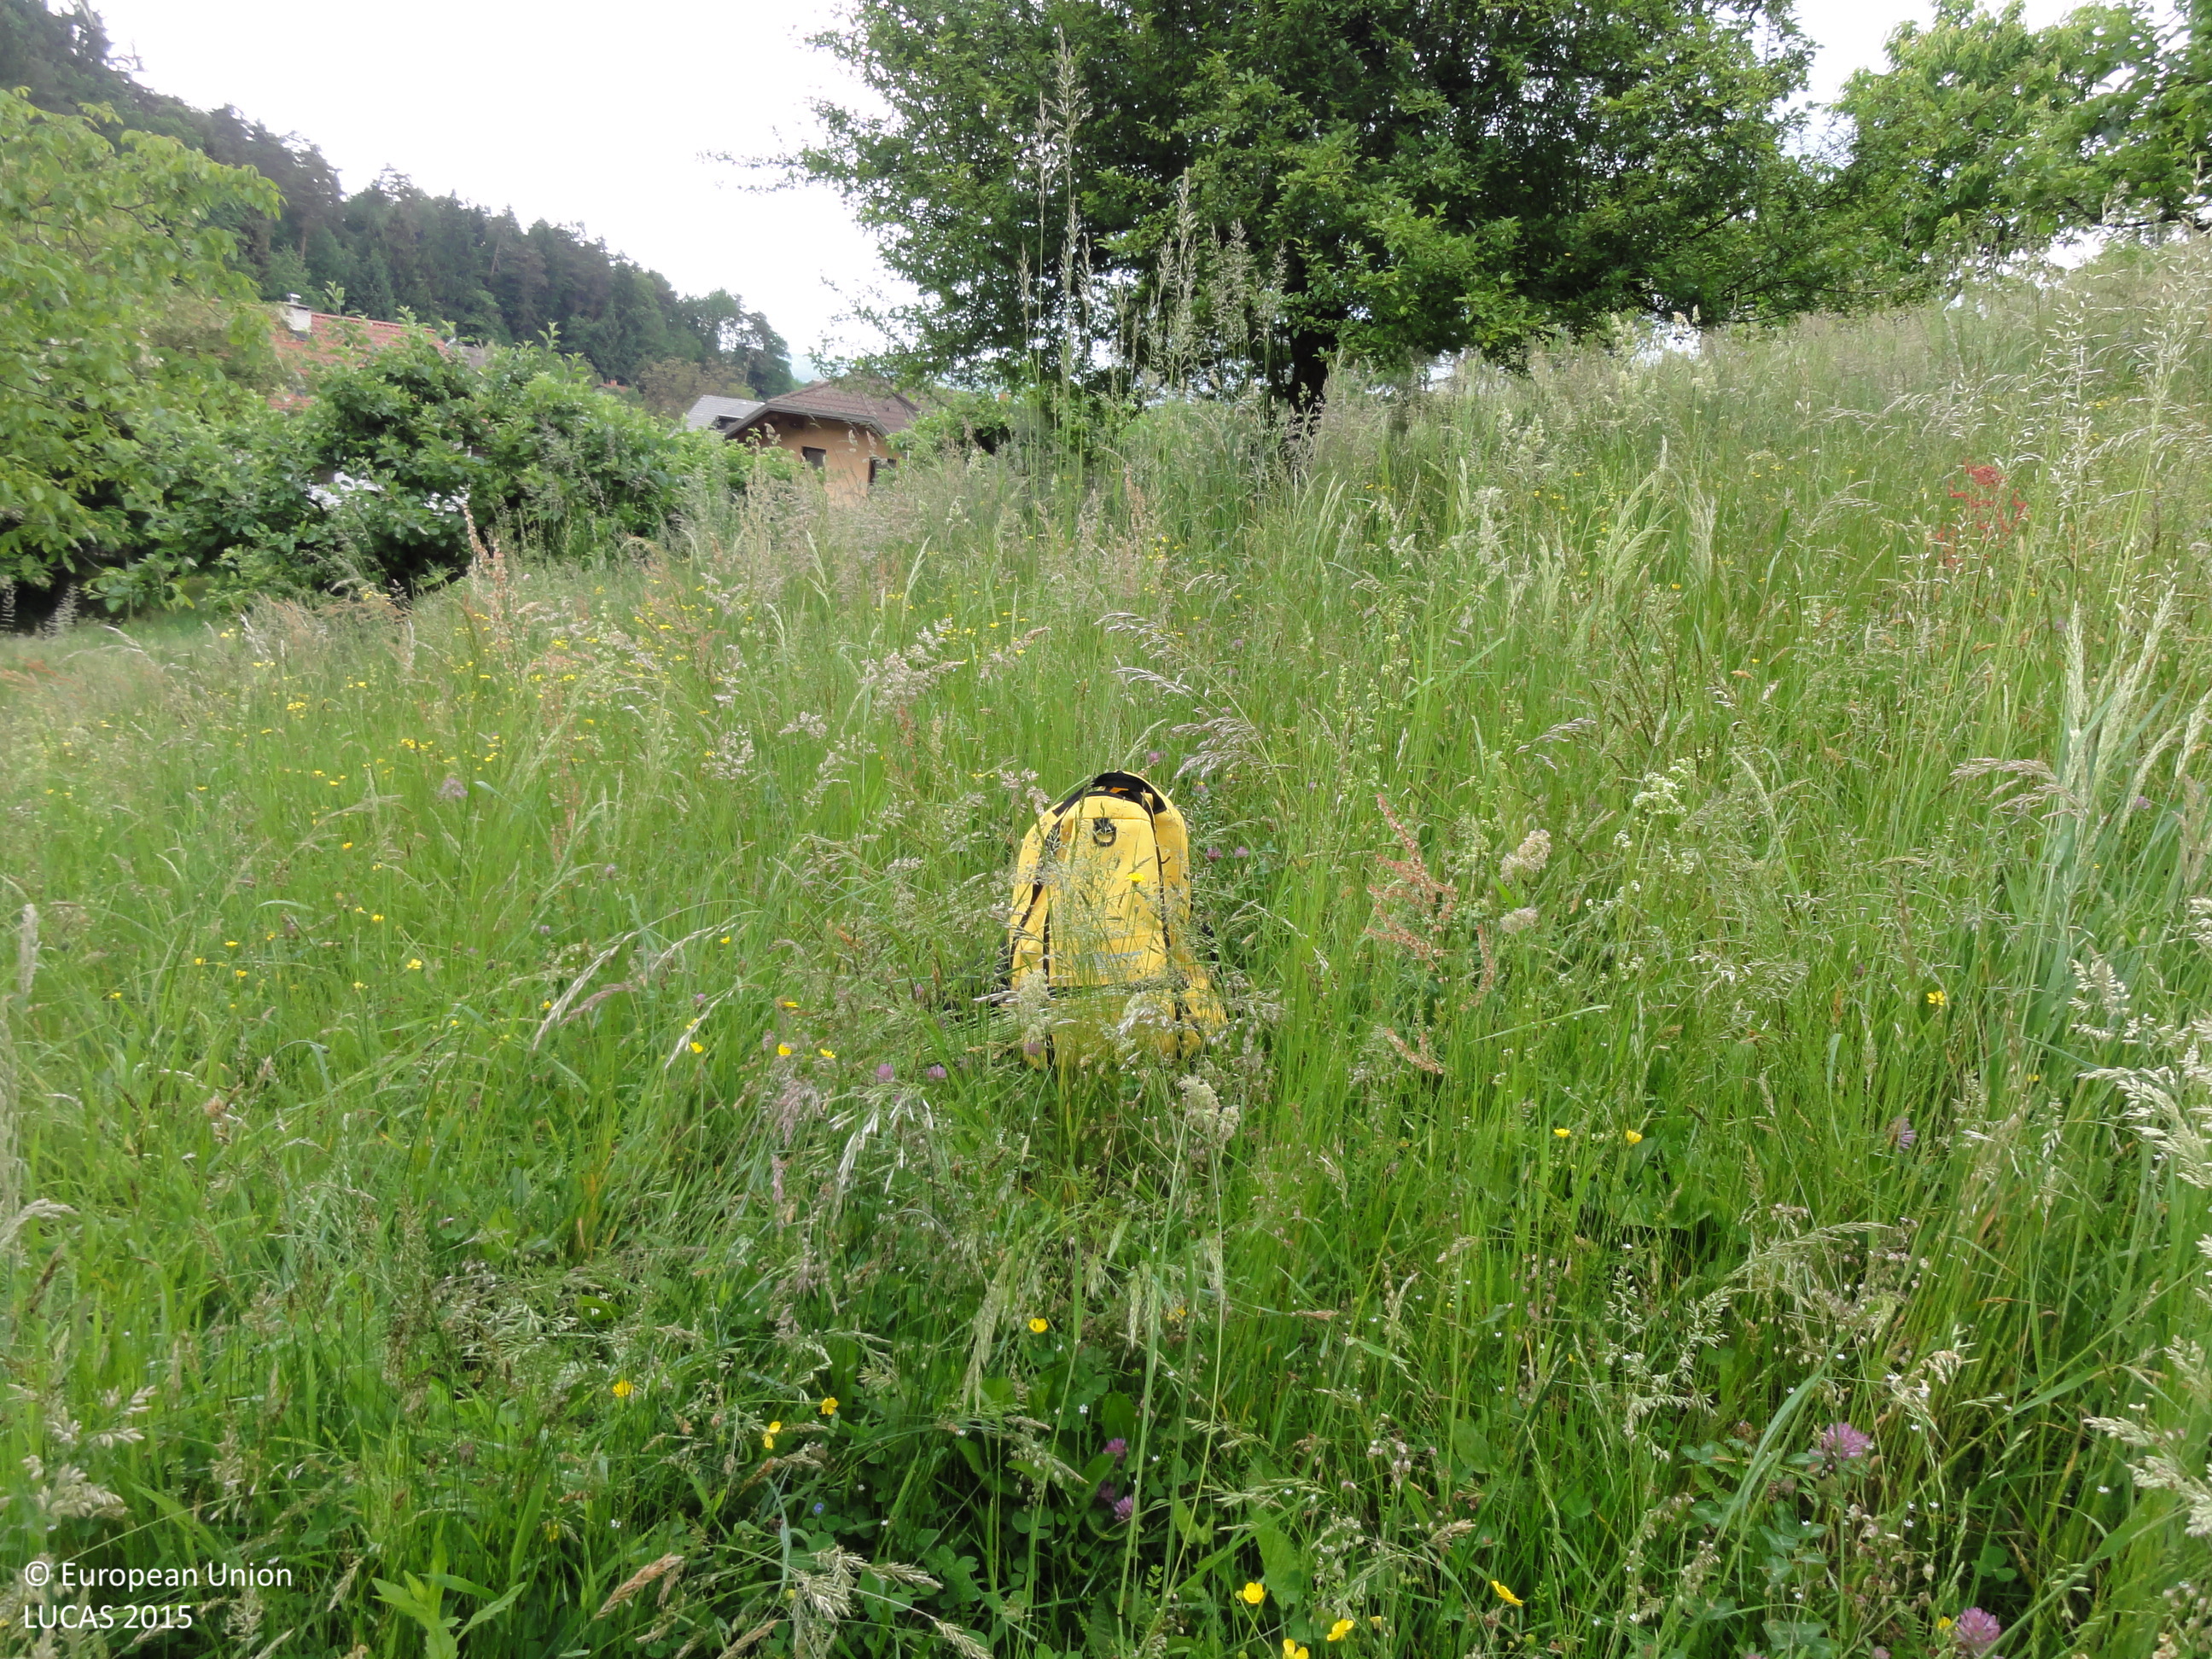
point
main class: Cropland
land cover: Apple fruit
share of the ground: 25 - 50 %
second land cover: Grassland without tree/shrub cover
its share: > 75 %
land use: Agriculture (excluding fallow land and kitchen gardens)
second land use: Residential
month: May
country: SI
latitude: 46.2274
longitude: 15.1449
